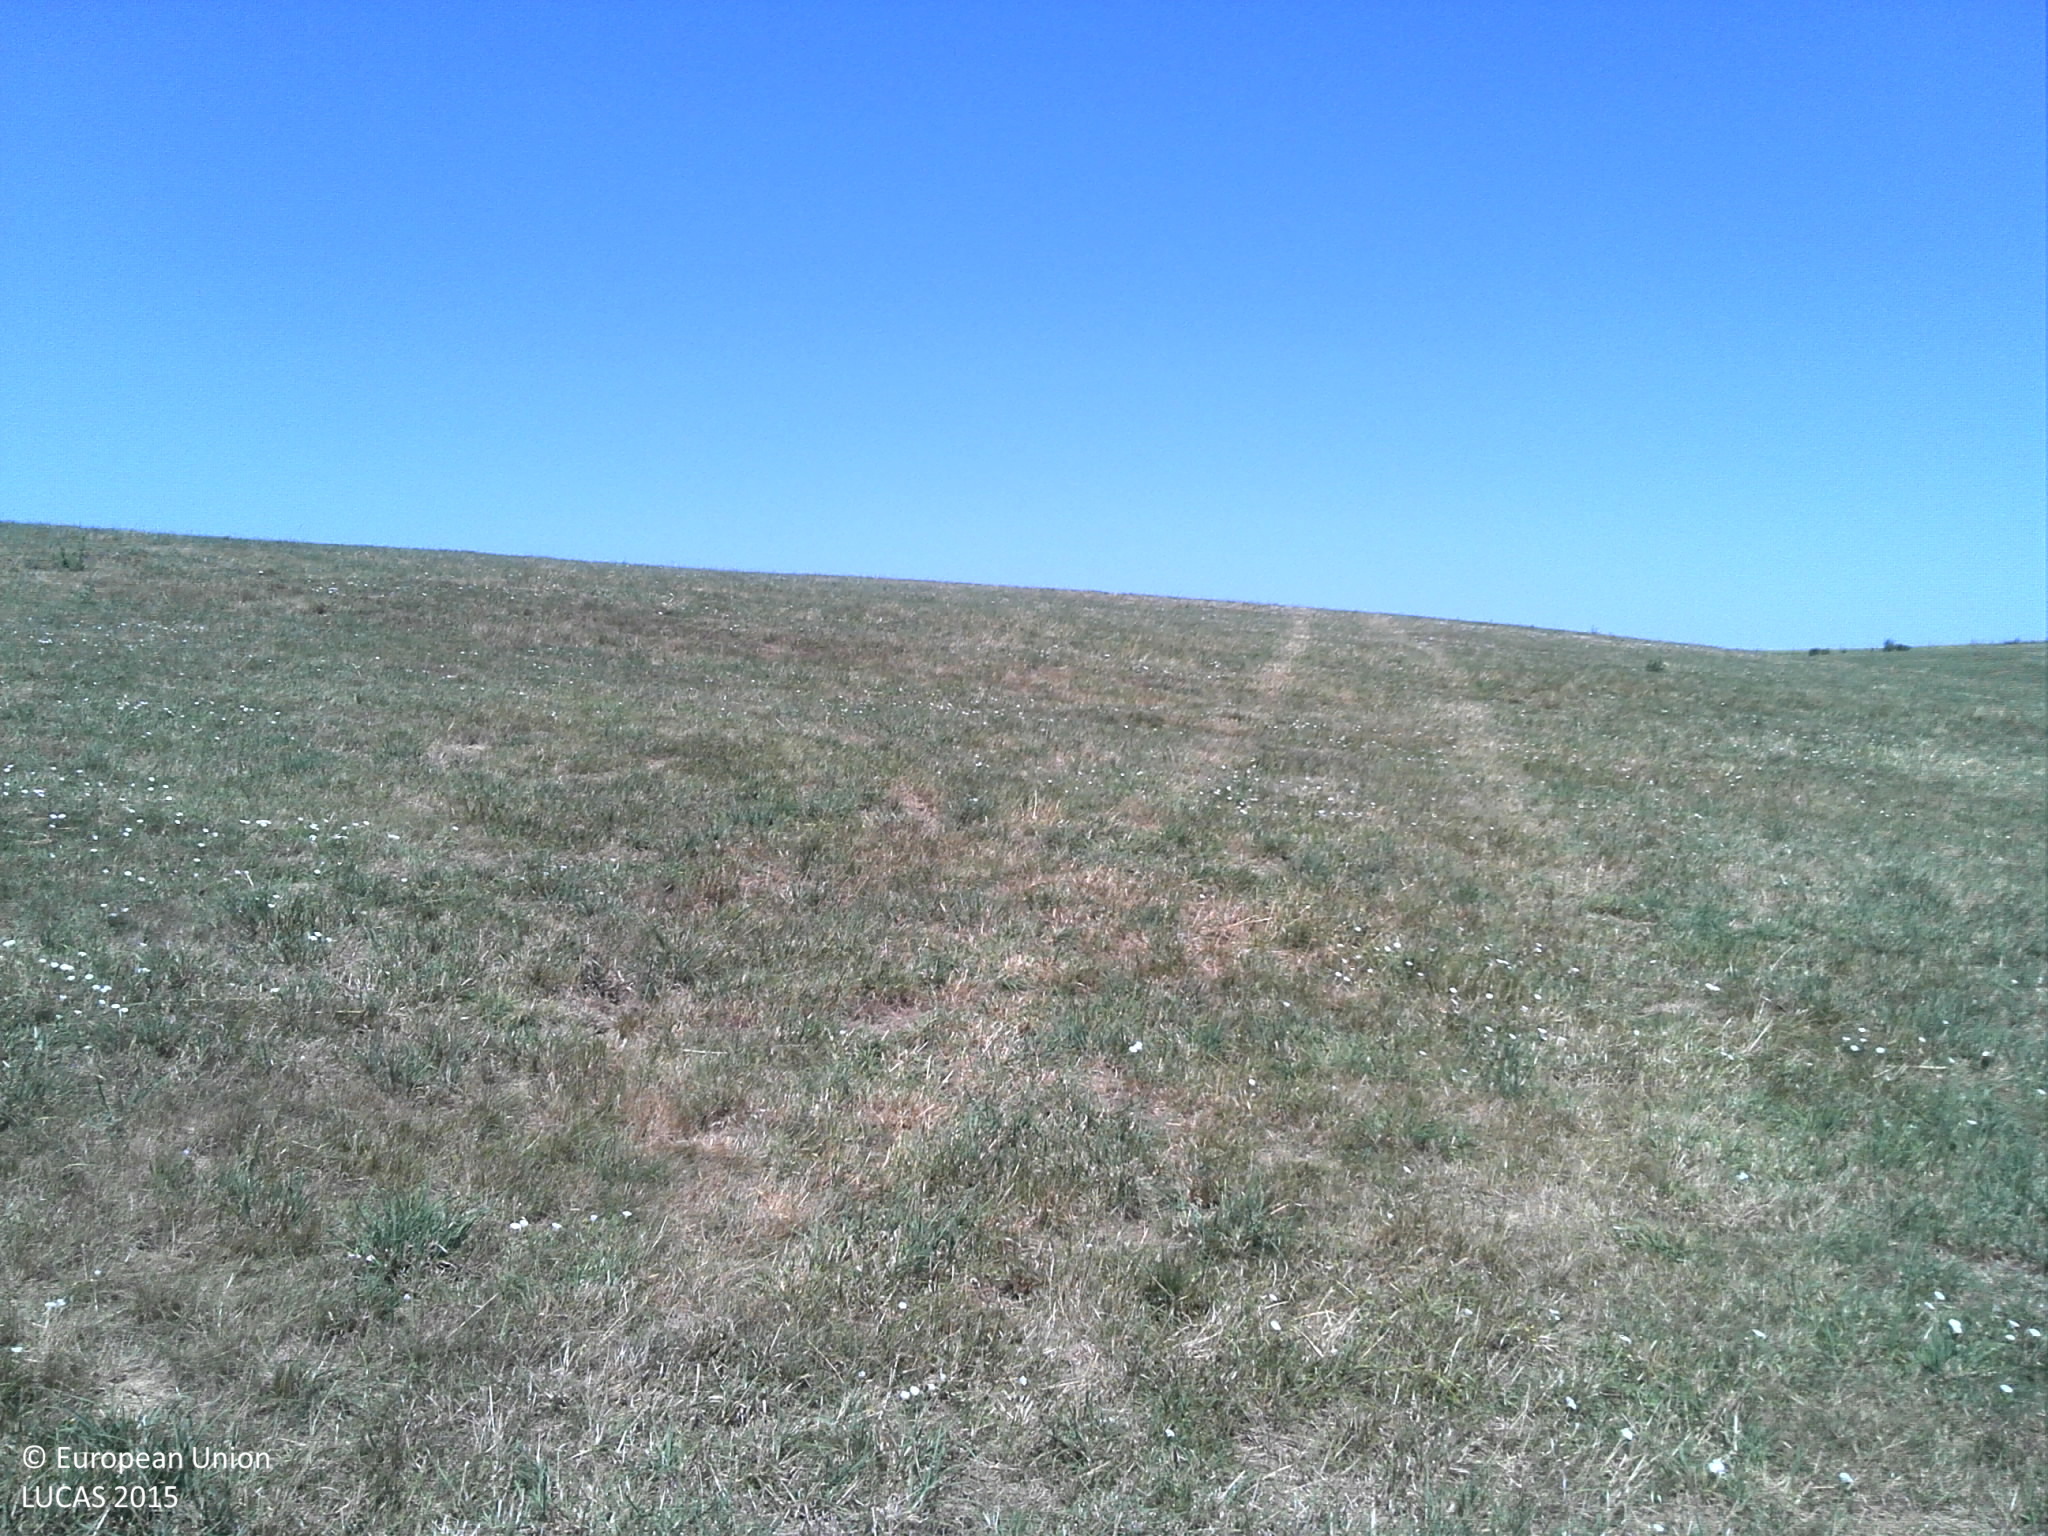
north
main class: Grassland
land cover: Grassland without tree/shrub cover
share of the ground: > 75 %
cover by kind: herbaceous plants 100 %
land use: Agriculture (excluding fallow land and kitchen gardens)
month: July
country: FR
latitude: 49.4559
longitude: 6.2334
